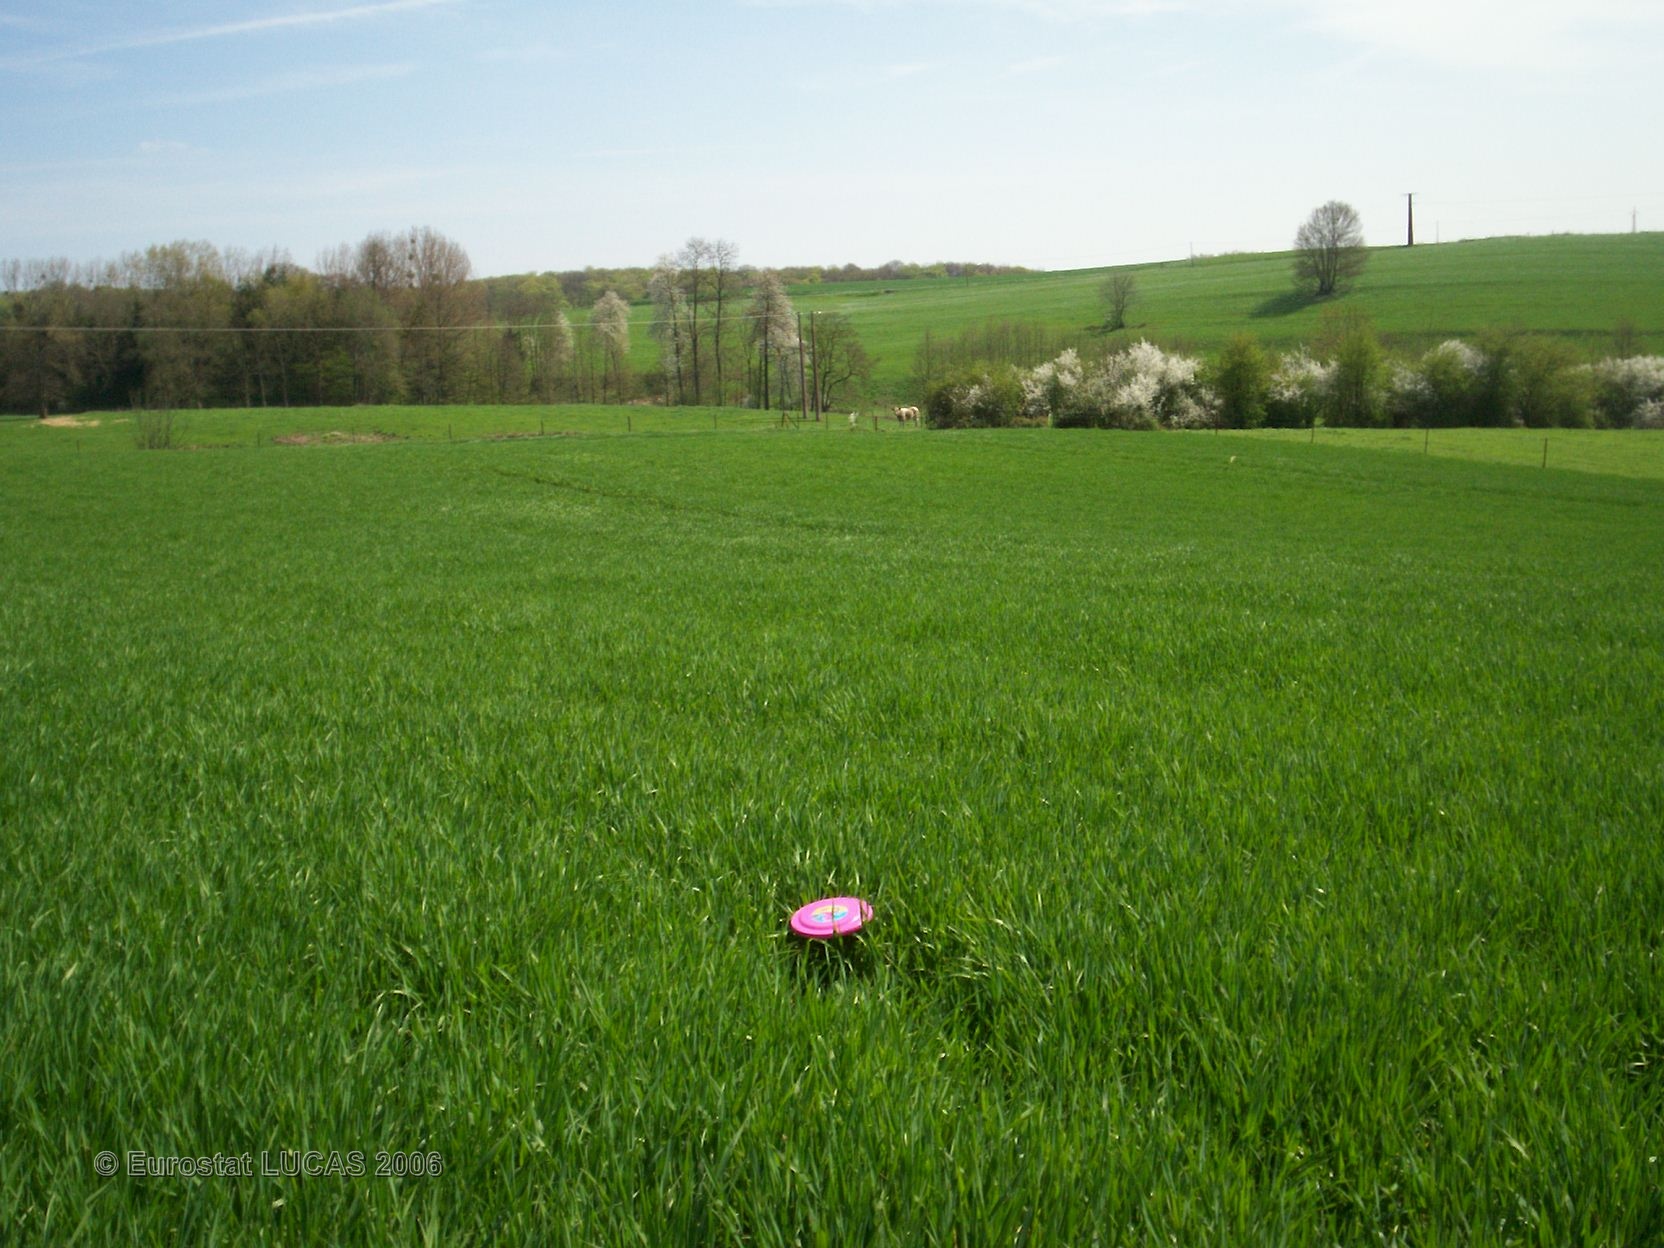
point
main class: Cropland
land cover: Common wheat
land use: Agriculture (excluding fallow land and kitchen gardens)
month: April
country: FR
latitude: 49.7376
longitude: 4.3483
